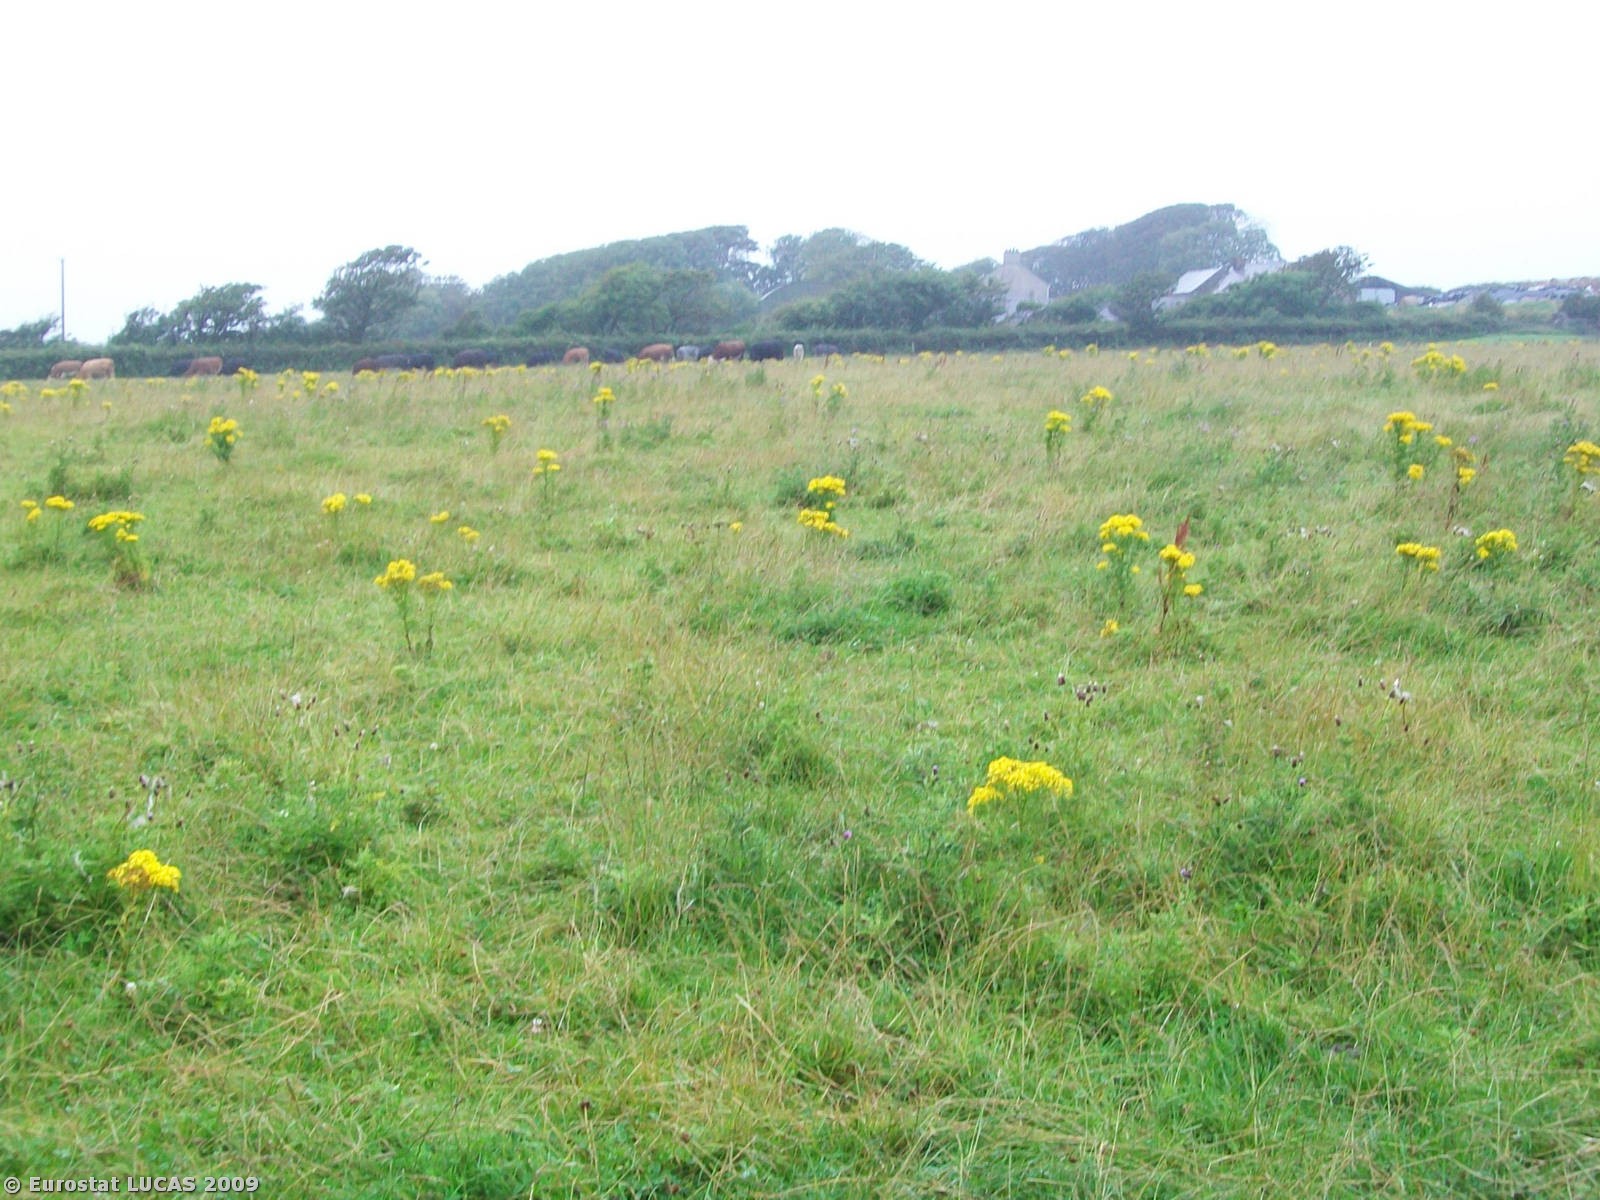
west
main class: Grassland
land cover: Grassland without tree/shrub cover
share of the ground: > 75 %
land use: Agriculture (excluding fallow land and kitchen gardens)
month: August
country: GB
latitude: 54.2716
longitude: -5.5936
